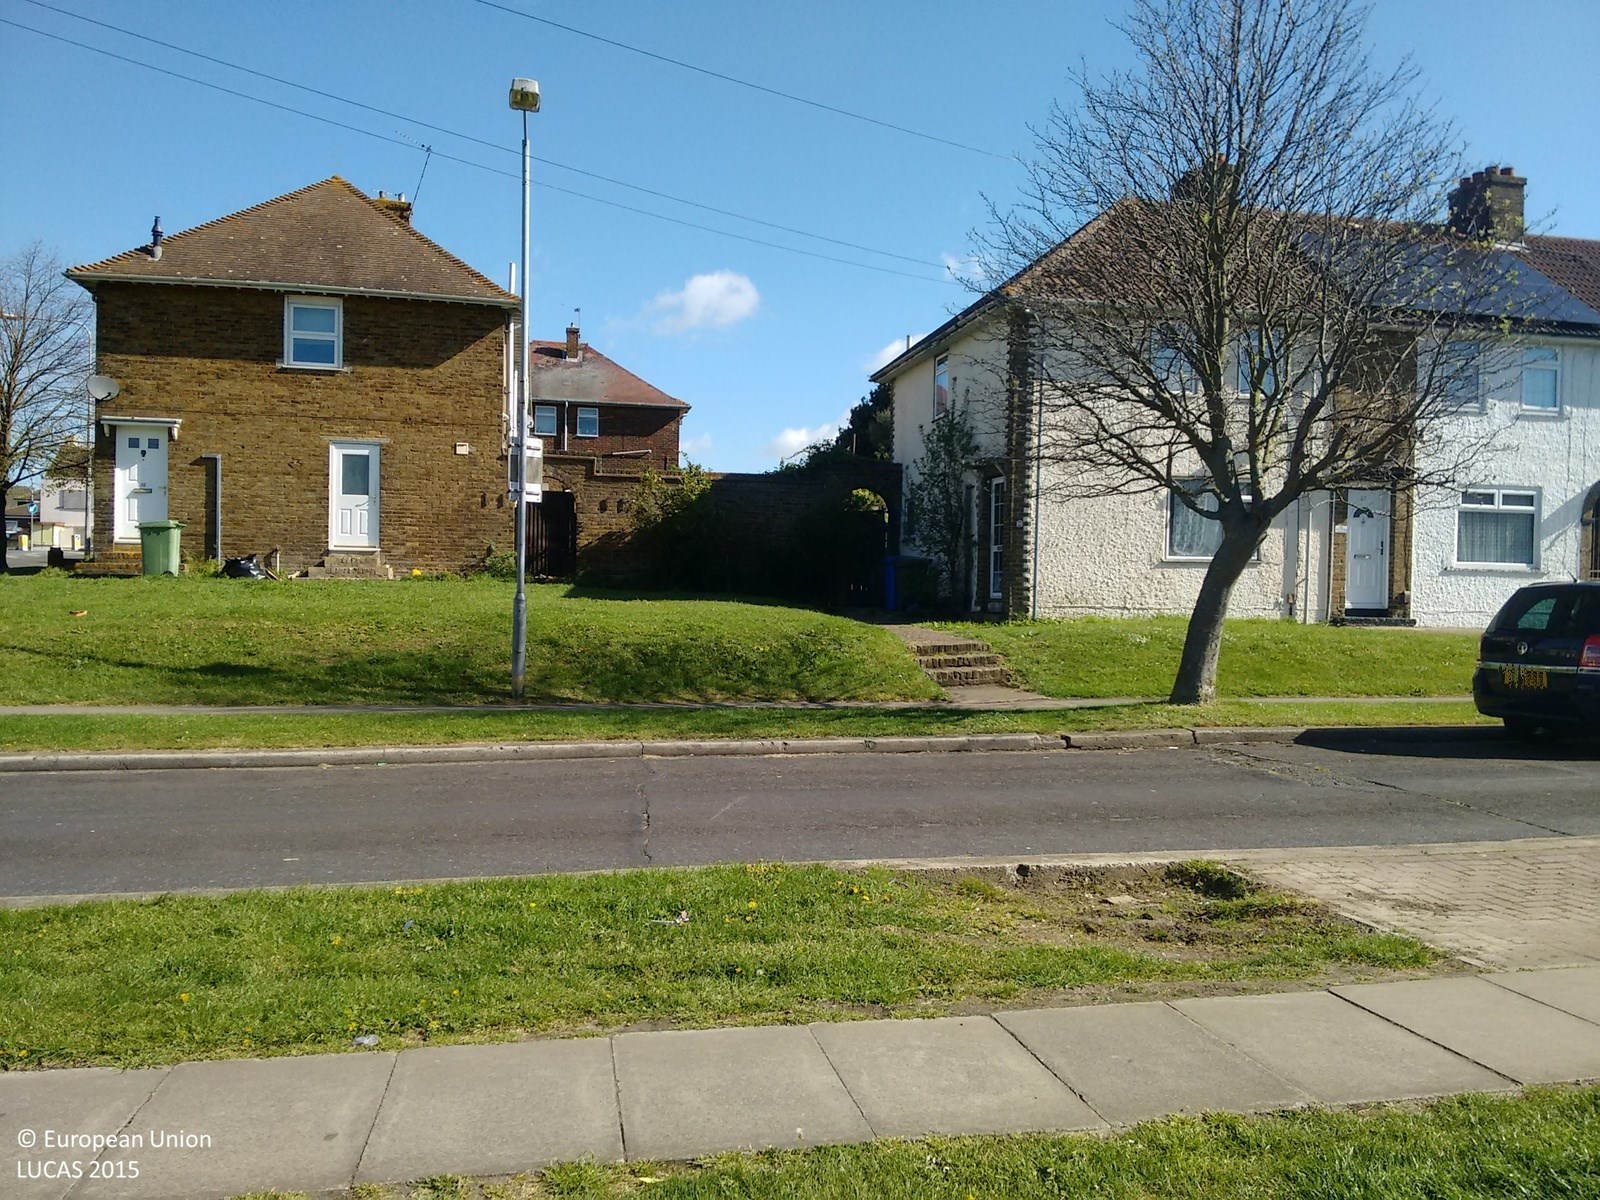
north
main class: Grassland
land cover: Grassland without tree/shrub cover
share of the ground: > 75 %
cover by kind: herbaceous plants 100 %
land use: Residential
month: April
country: GB
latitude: 51.3633
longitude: 0.7393
